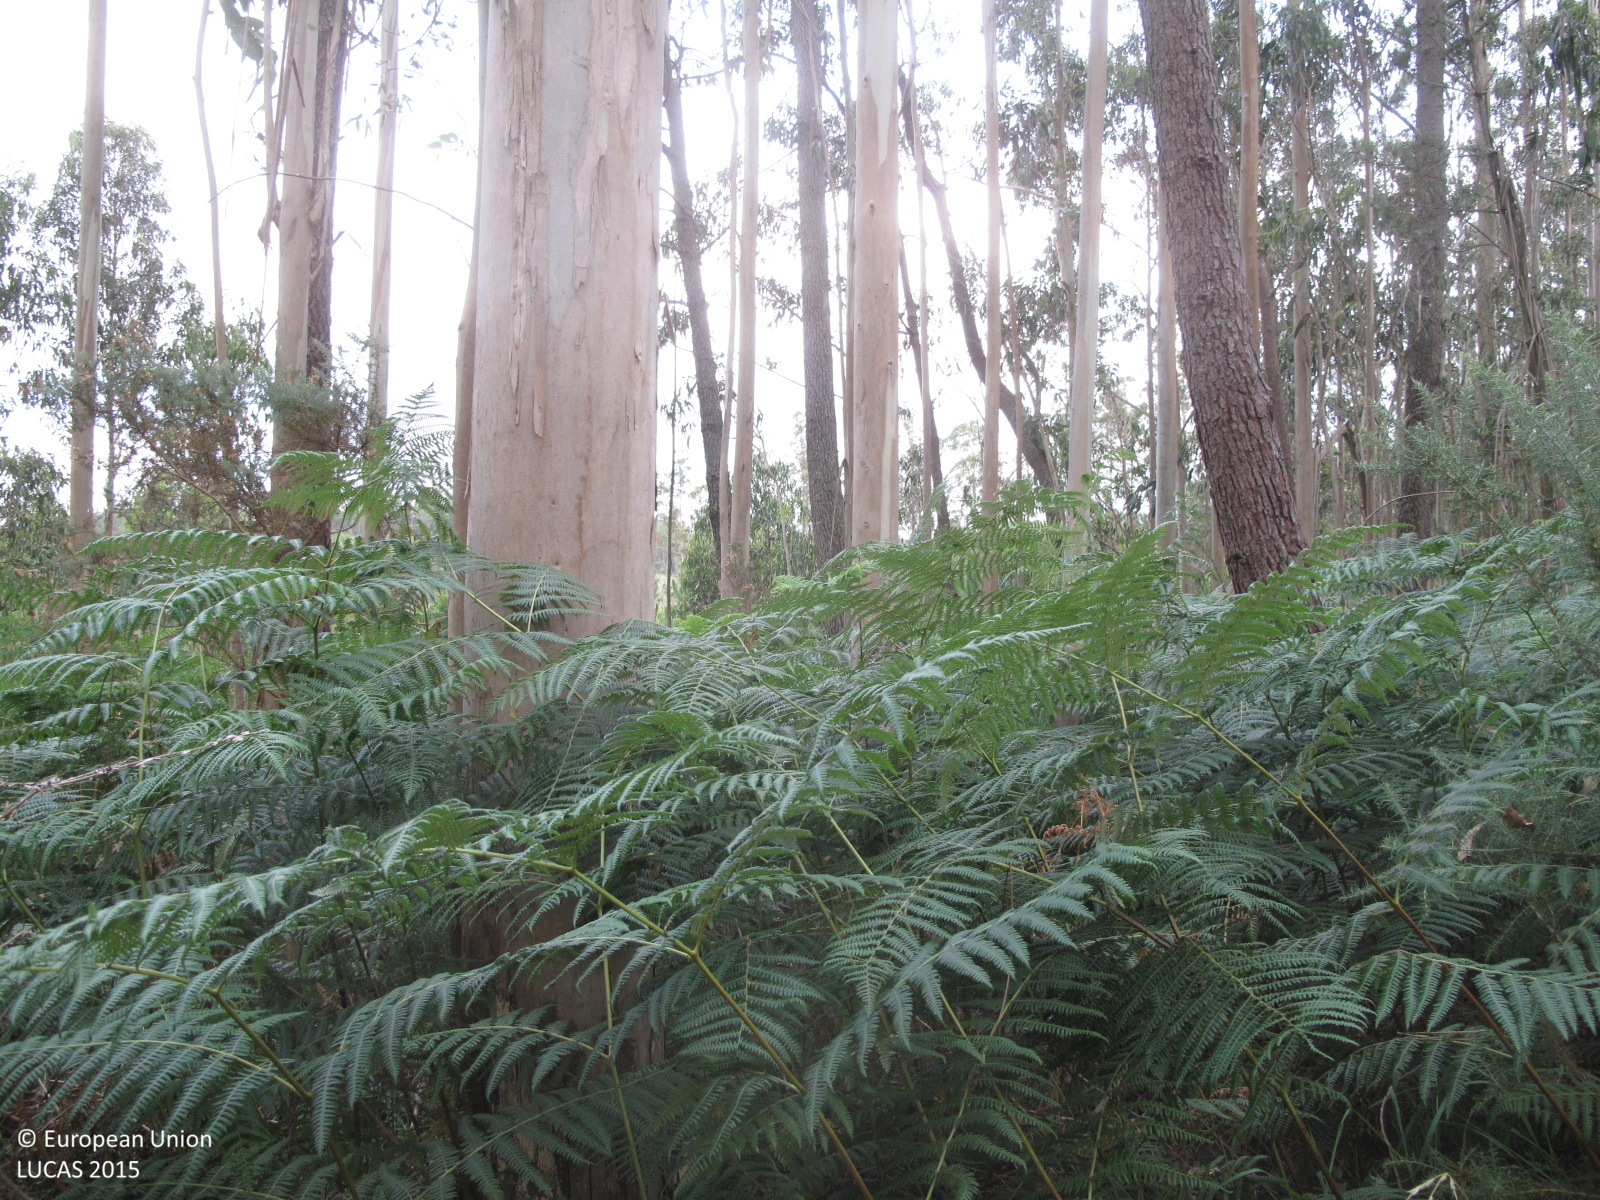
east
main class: Woodland
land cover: Broadleaved woodland
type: exotic forest
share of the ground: 25 - 50 %
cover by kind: shrubs 50 %, broadleaved forest trees 30 %, herbaceous plants 20 %
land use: Forestry
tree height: > 5 m
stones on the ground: < 10 %
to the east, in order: Broadleaved woodland; Tracks; Other mixed woodland; Tracks; Broadleaved woodland; Pine dominated coniferous woodland; Broadleaved woodland; Rivers and streams; Broadleaved woodland; Tracks; Broadleaved woodland
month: July
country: ES
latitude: 43.1459
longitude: -8.7175
